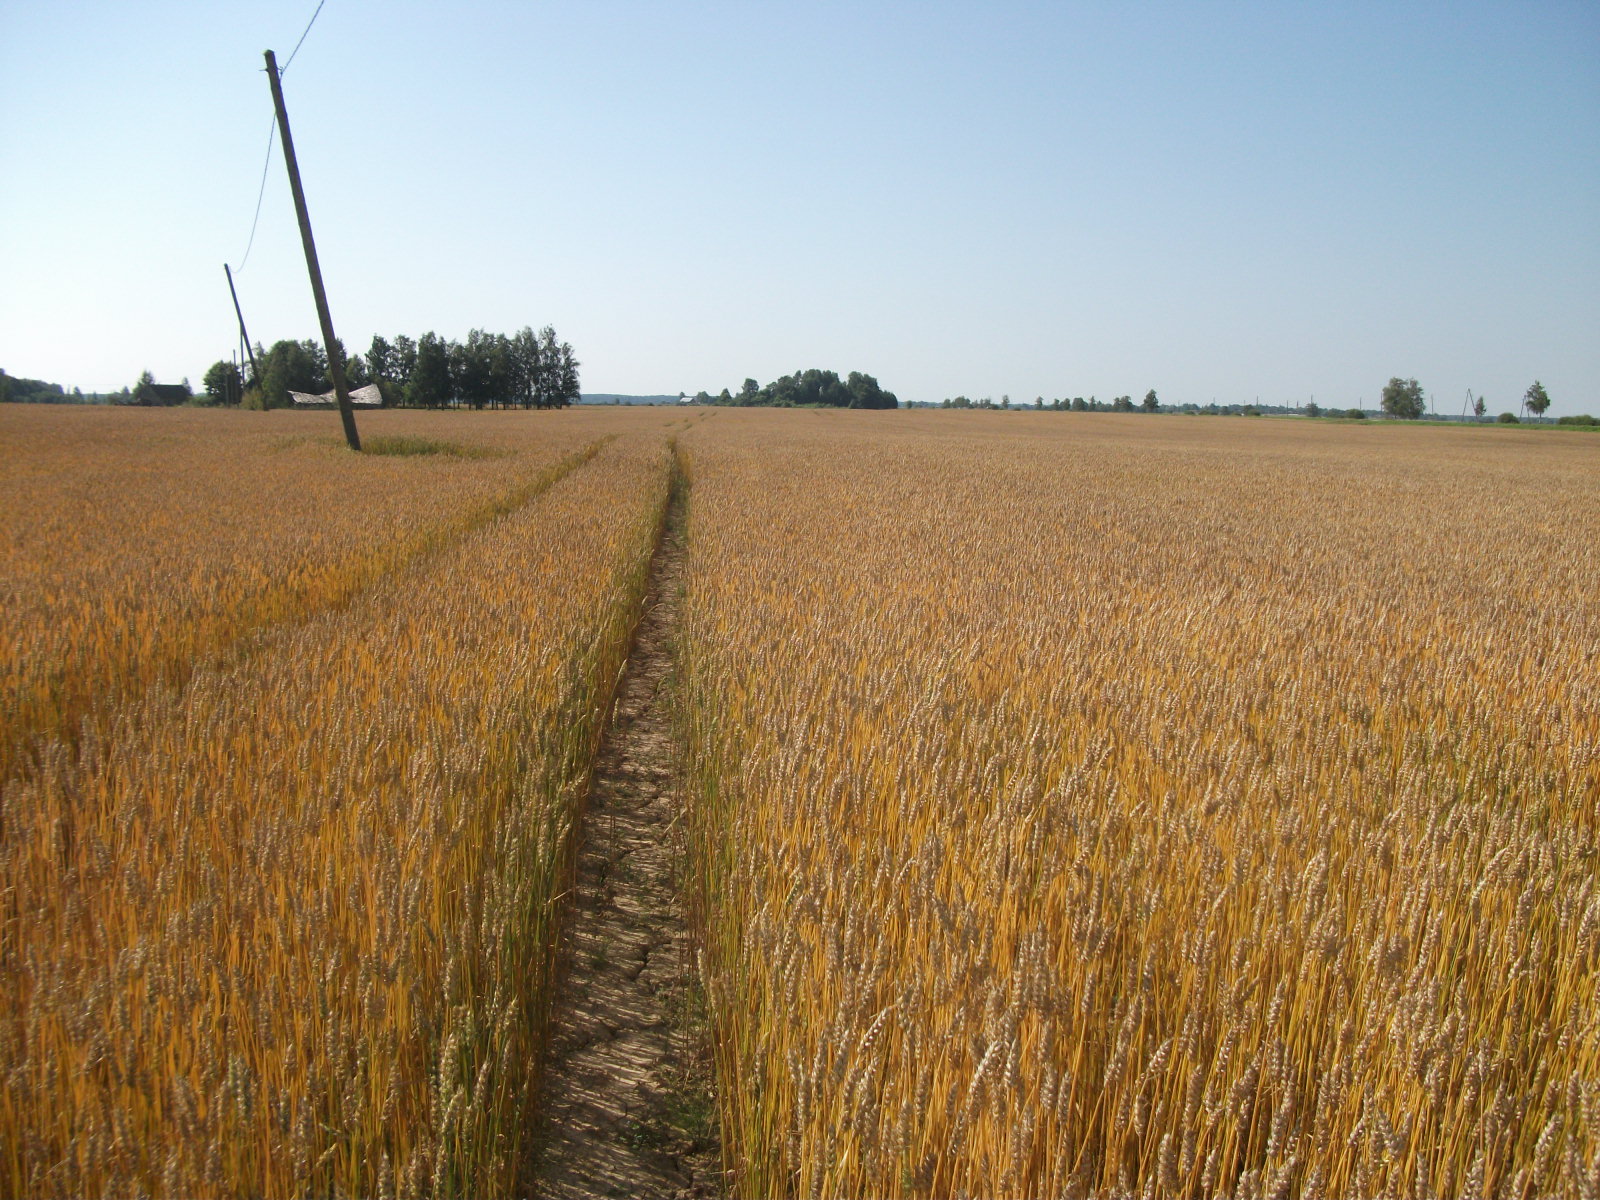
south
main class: Cropland
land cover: Common wheat
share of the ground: > 75 %
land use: Agriculture (excluding fallow land and kitchen gardens)
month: August
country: LV
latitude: 56.6974
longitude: 26.5943
